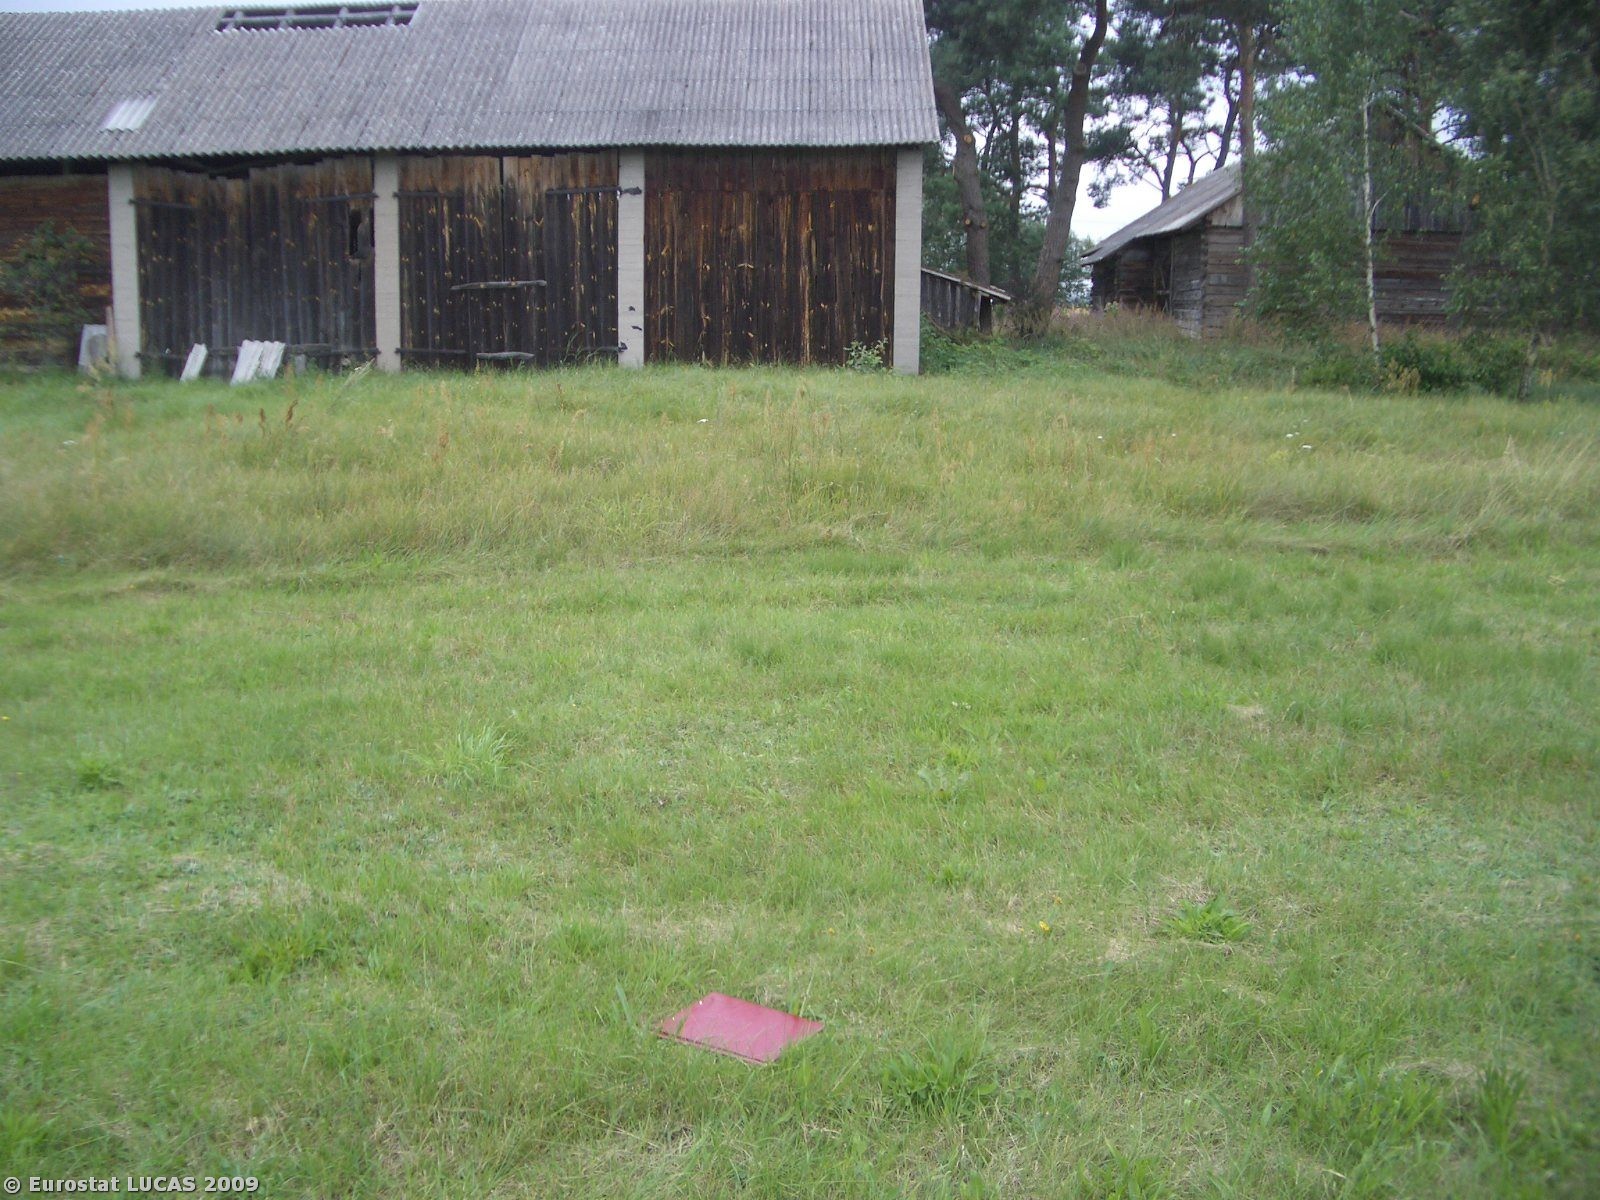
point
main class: Grassland
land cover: Grassland without tree/shrub cover
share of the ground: > 75 %
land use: Agriculture (excluding fallow land and kitchen gardens)
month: August
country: PL
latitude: 51.9234
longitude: 23.2391
